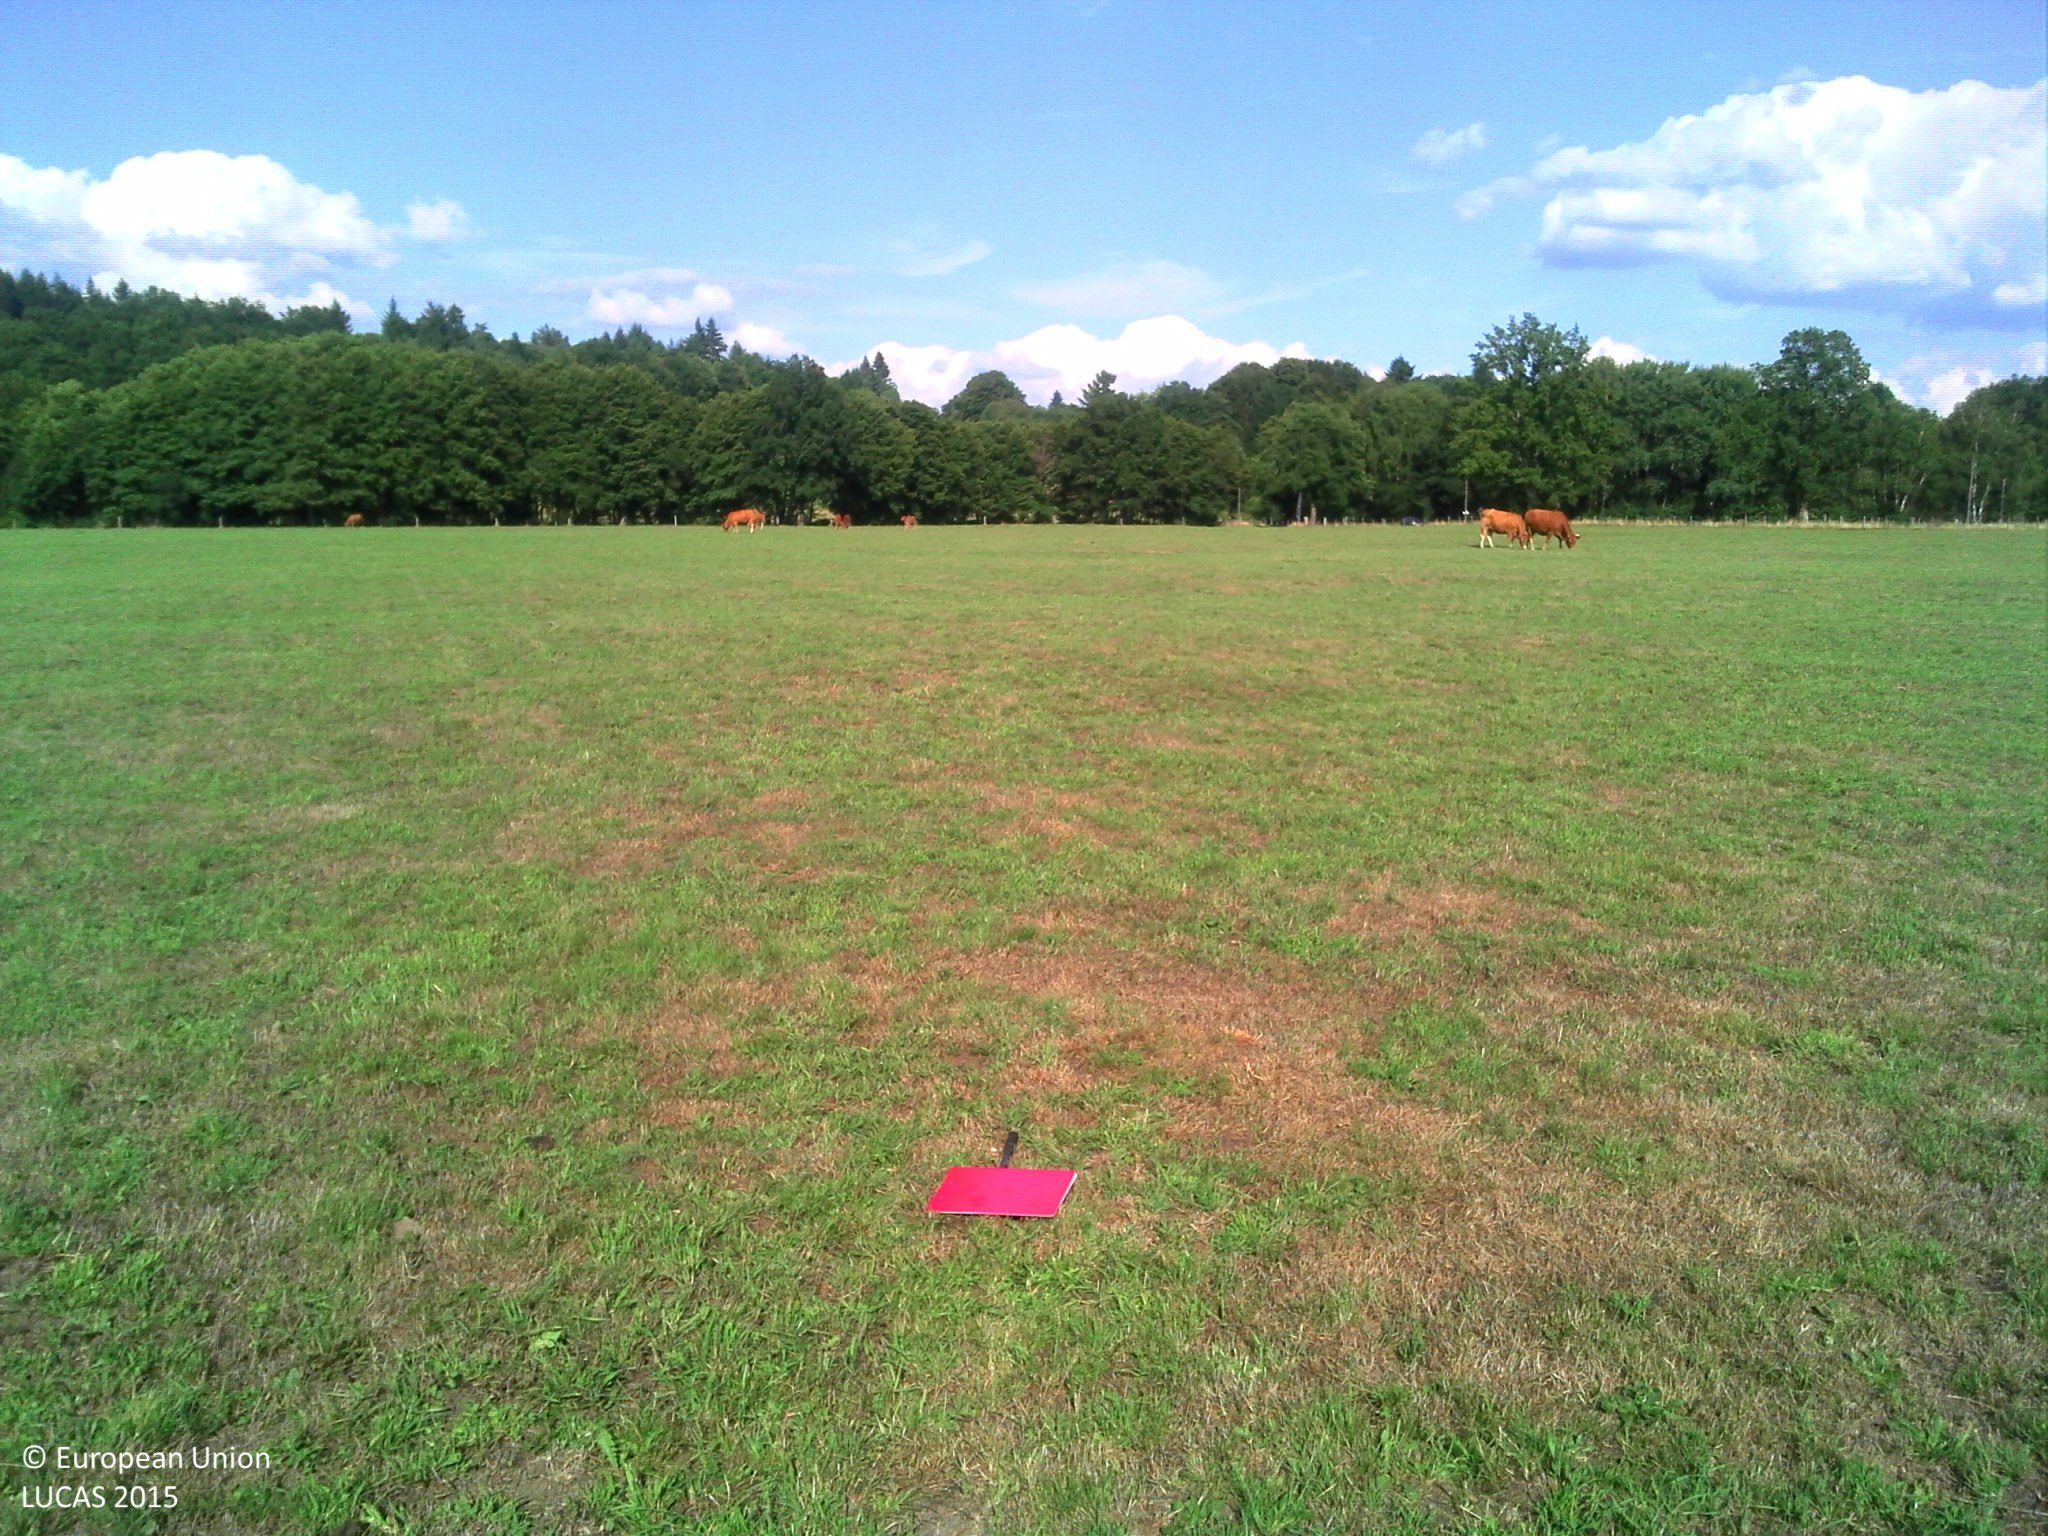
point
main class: Grassland
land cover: Grassland without tree/shrub cover
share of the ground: > 75 %
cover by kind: herbaceous plants 100 %
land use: Agriculture (excluding fallow land and kitchen gardens)
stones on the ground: < 10 %
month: August
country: FR
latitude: 45.9377
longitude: 1.6996
